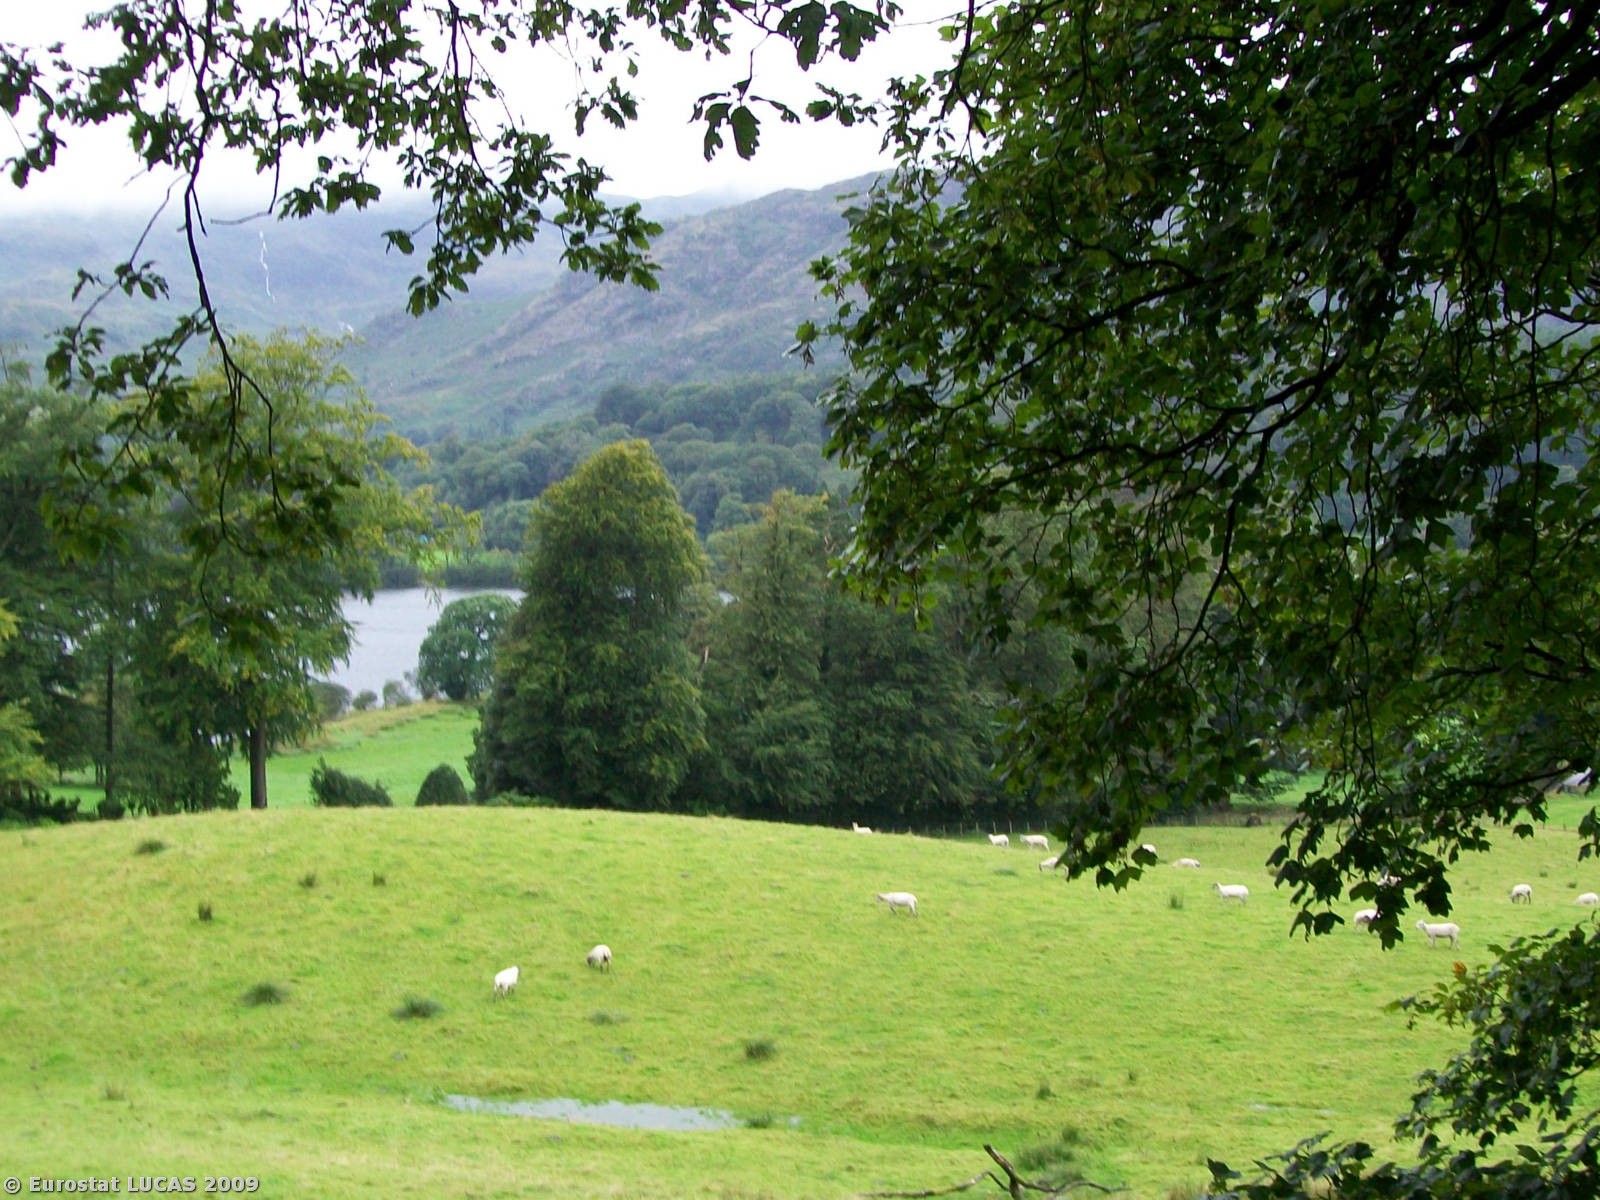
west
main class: Grassland
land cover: Grassland with sparse tree/shrub cover
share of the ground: > 75 %
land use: Agriculture (excluding fallow land and kitchen gardens)
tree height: > 5 m
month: August
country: GB
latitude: 54.3688
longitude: -3.0492
